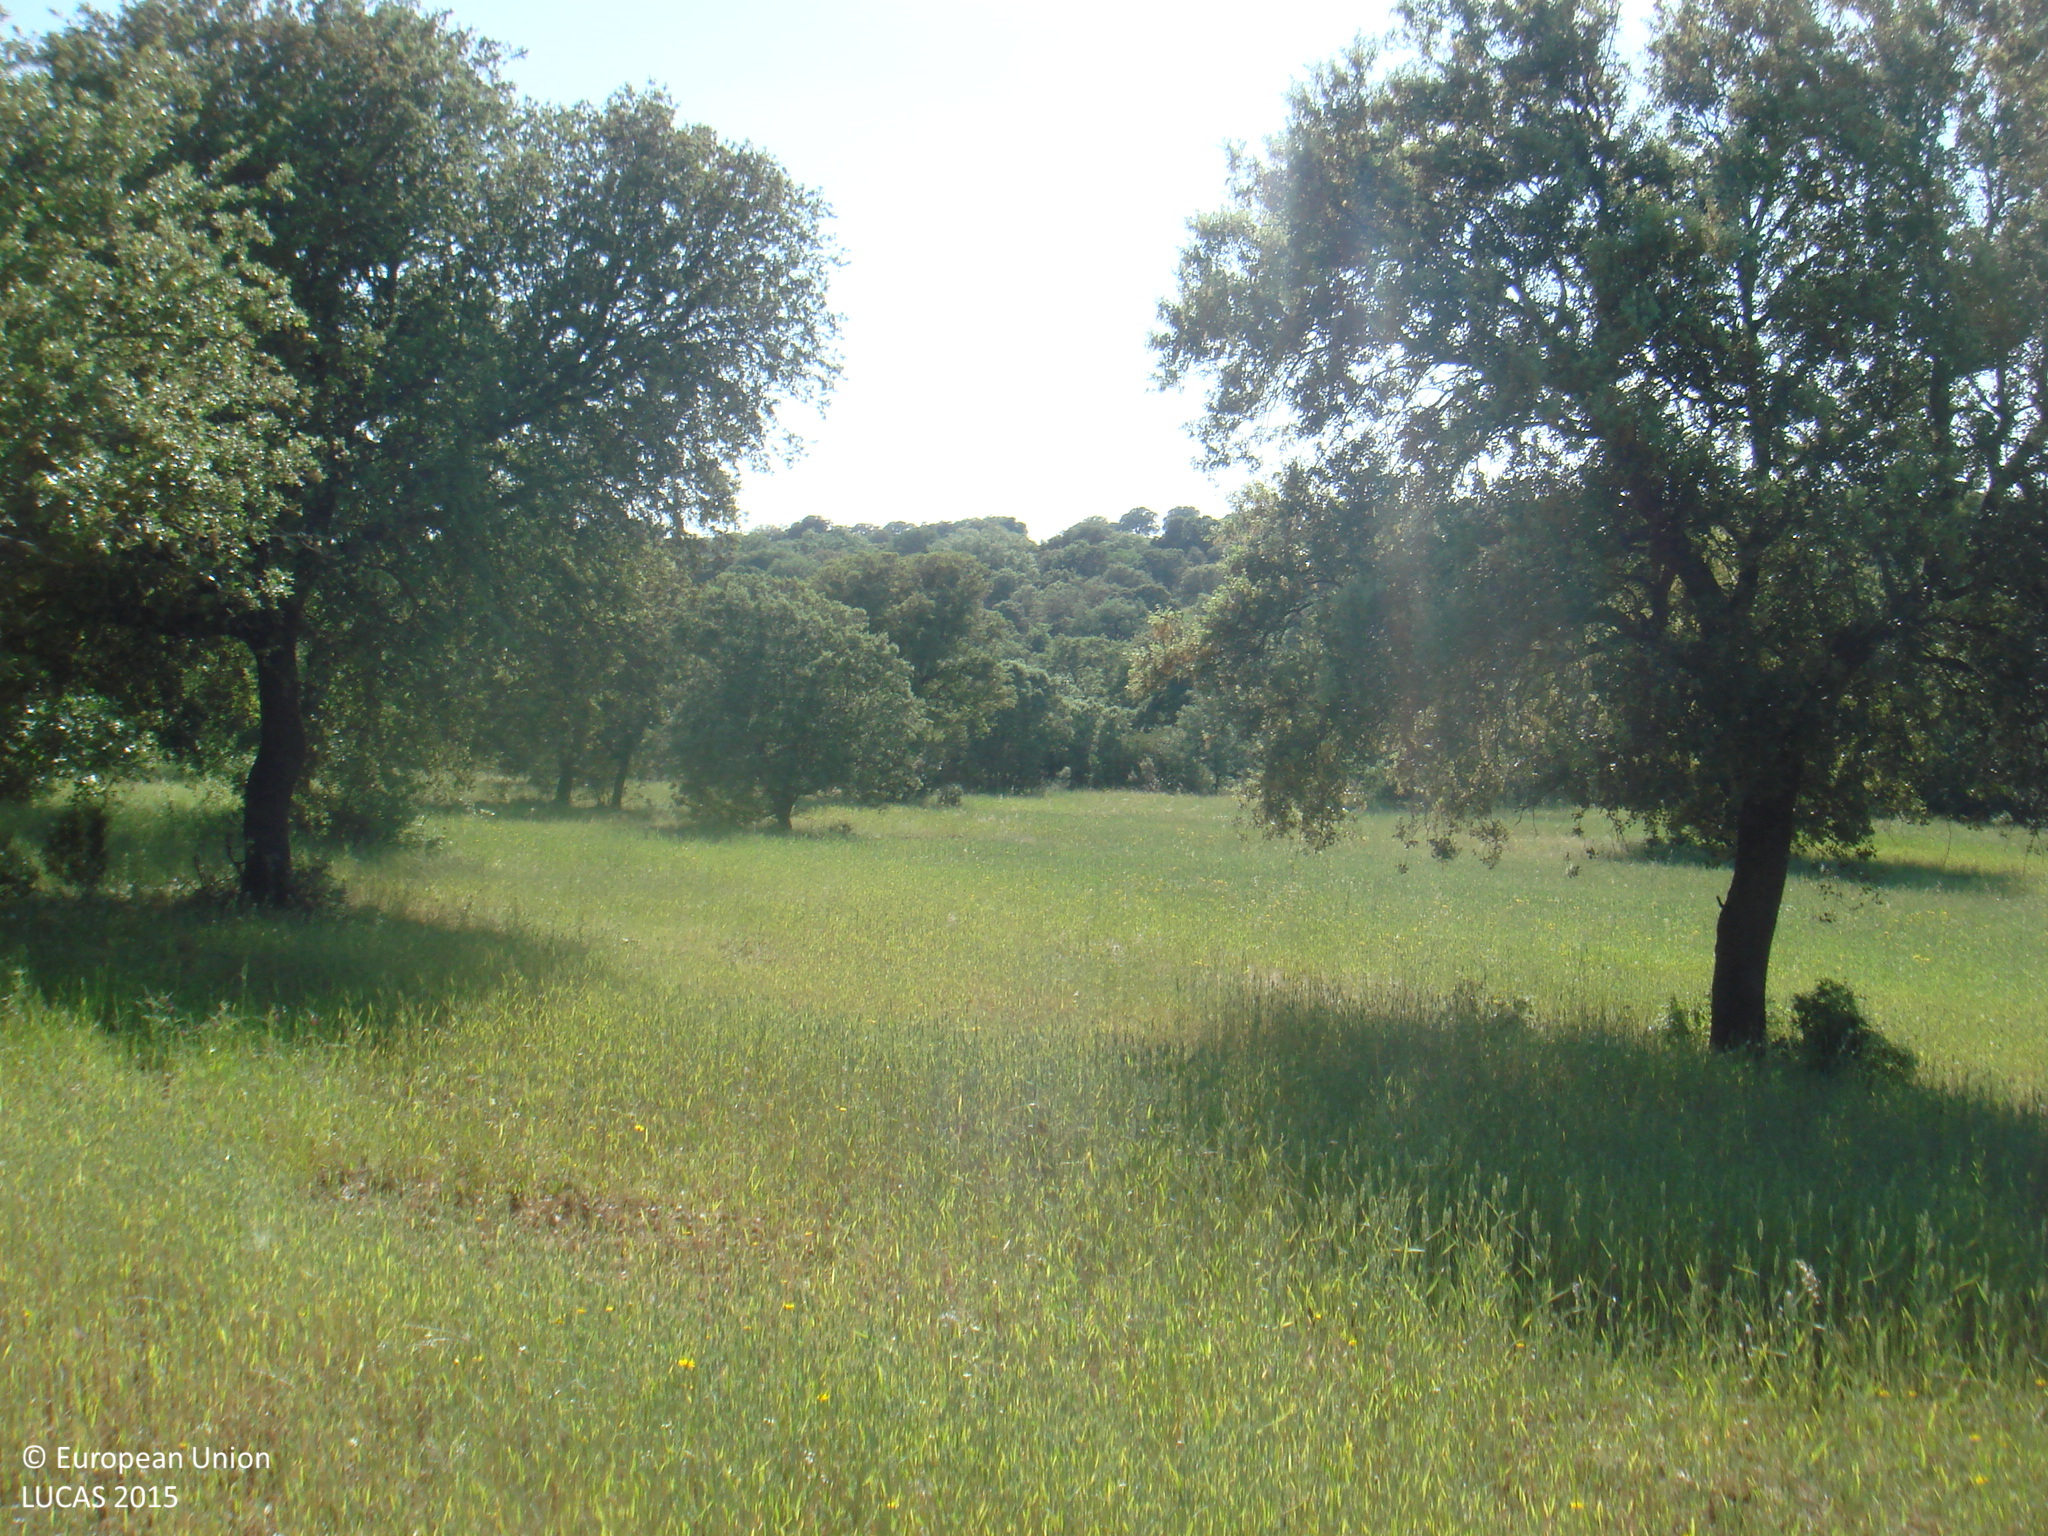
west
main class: Woodland
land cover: Broadleaved woodland
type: broadleaved evergreen forest
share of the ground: 50 - 75 %
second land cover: Common wheat
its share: > 75 %
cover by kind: herbaceous plants 60 %, broadleaved forest trees 40 %
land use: Forestry
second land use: Agriculture (excluding fallow land and kitchen gardens)
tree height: > 5 m
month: May
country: ES
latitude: 38.3966
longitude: -4.3640
